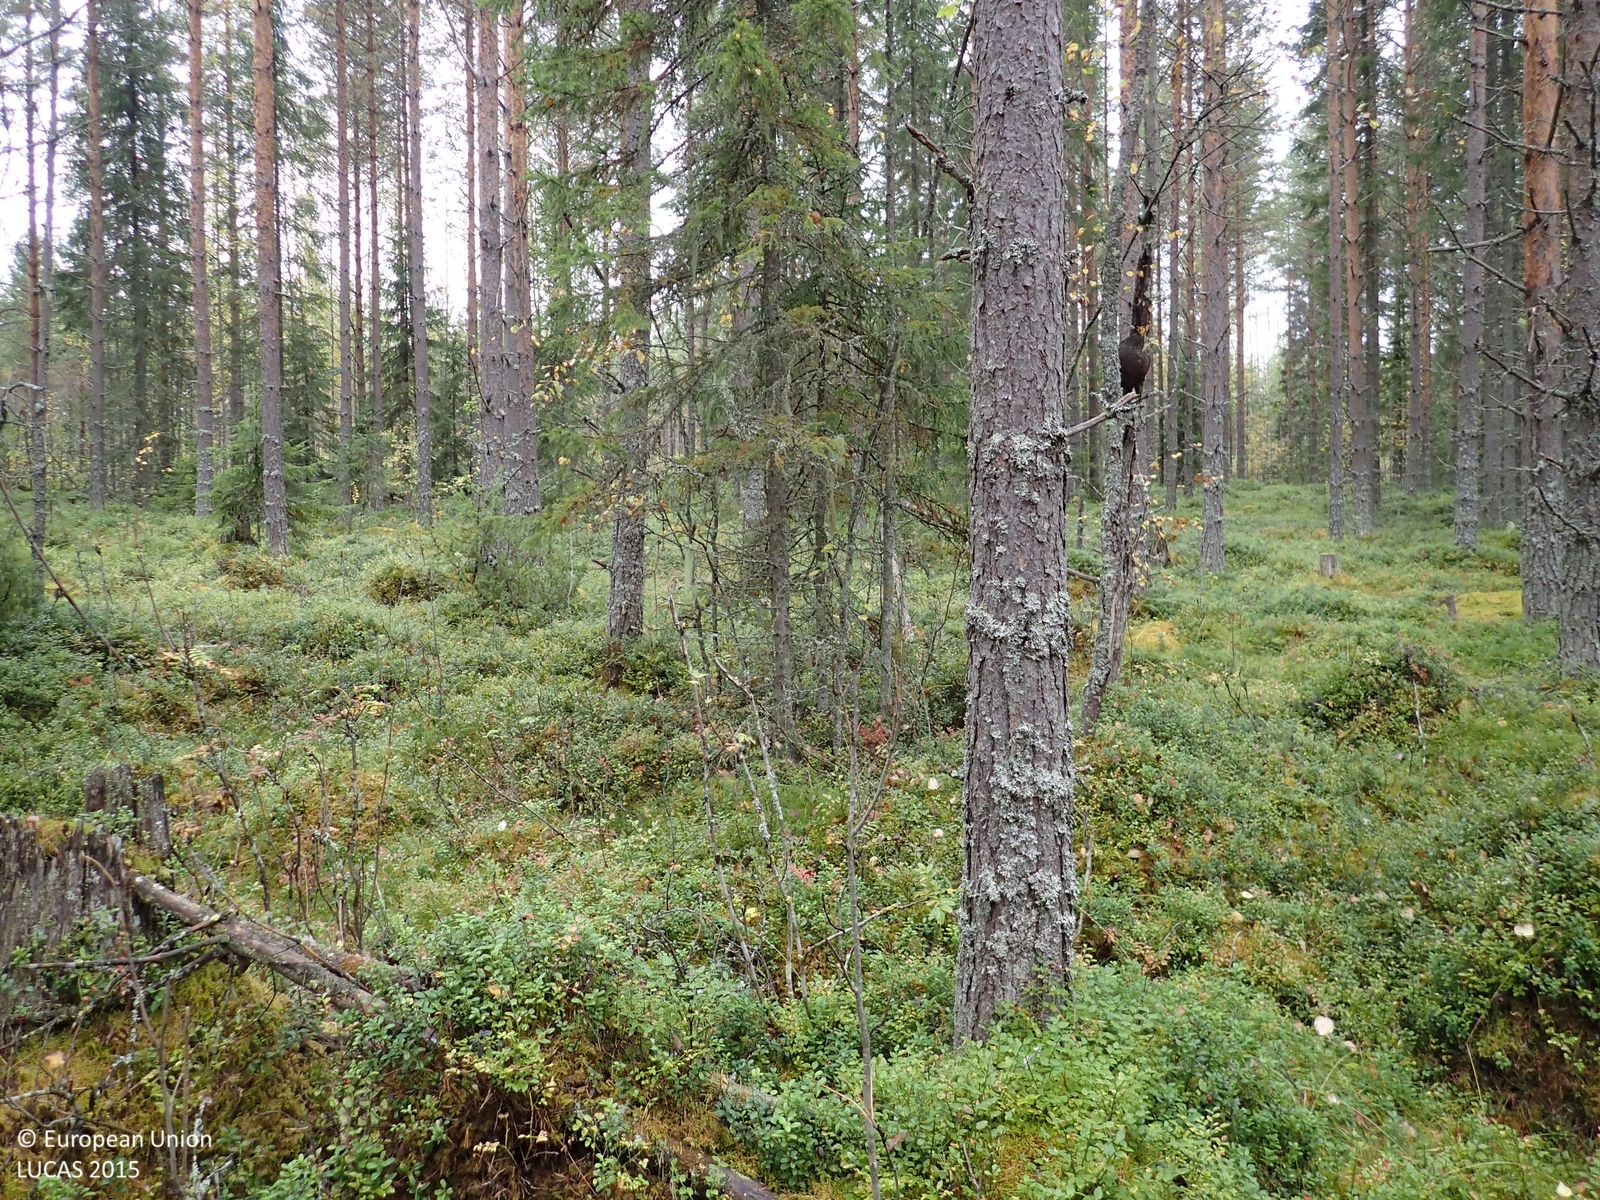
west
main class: Woodland
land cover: Other coniferous woodland
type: boreal forest
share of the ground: > 75 %
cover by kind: coniferous forest trees 70 %, shrubs 20 %, broadleaved forest trees 5 %, lichens and mosses 5 %
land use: Forestry
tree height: > 5 m
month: September
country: FI
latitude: 63.2616
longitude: 25.6670
